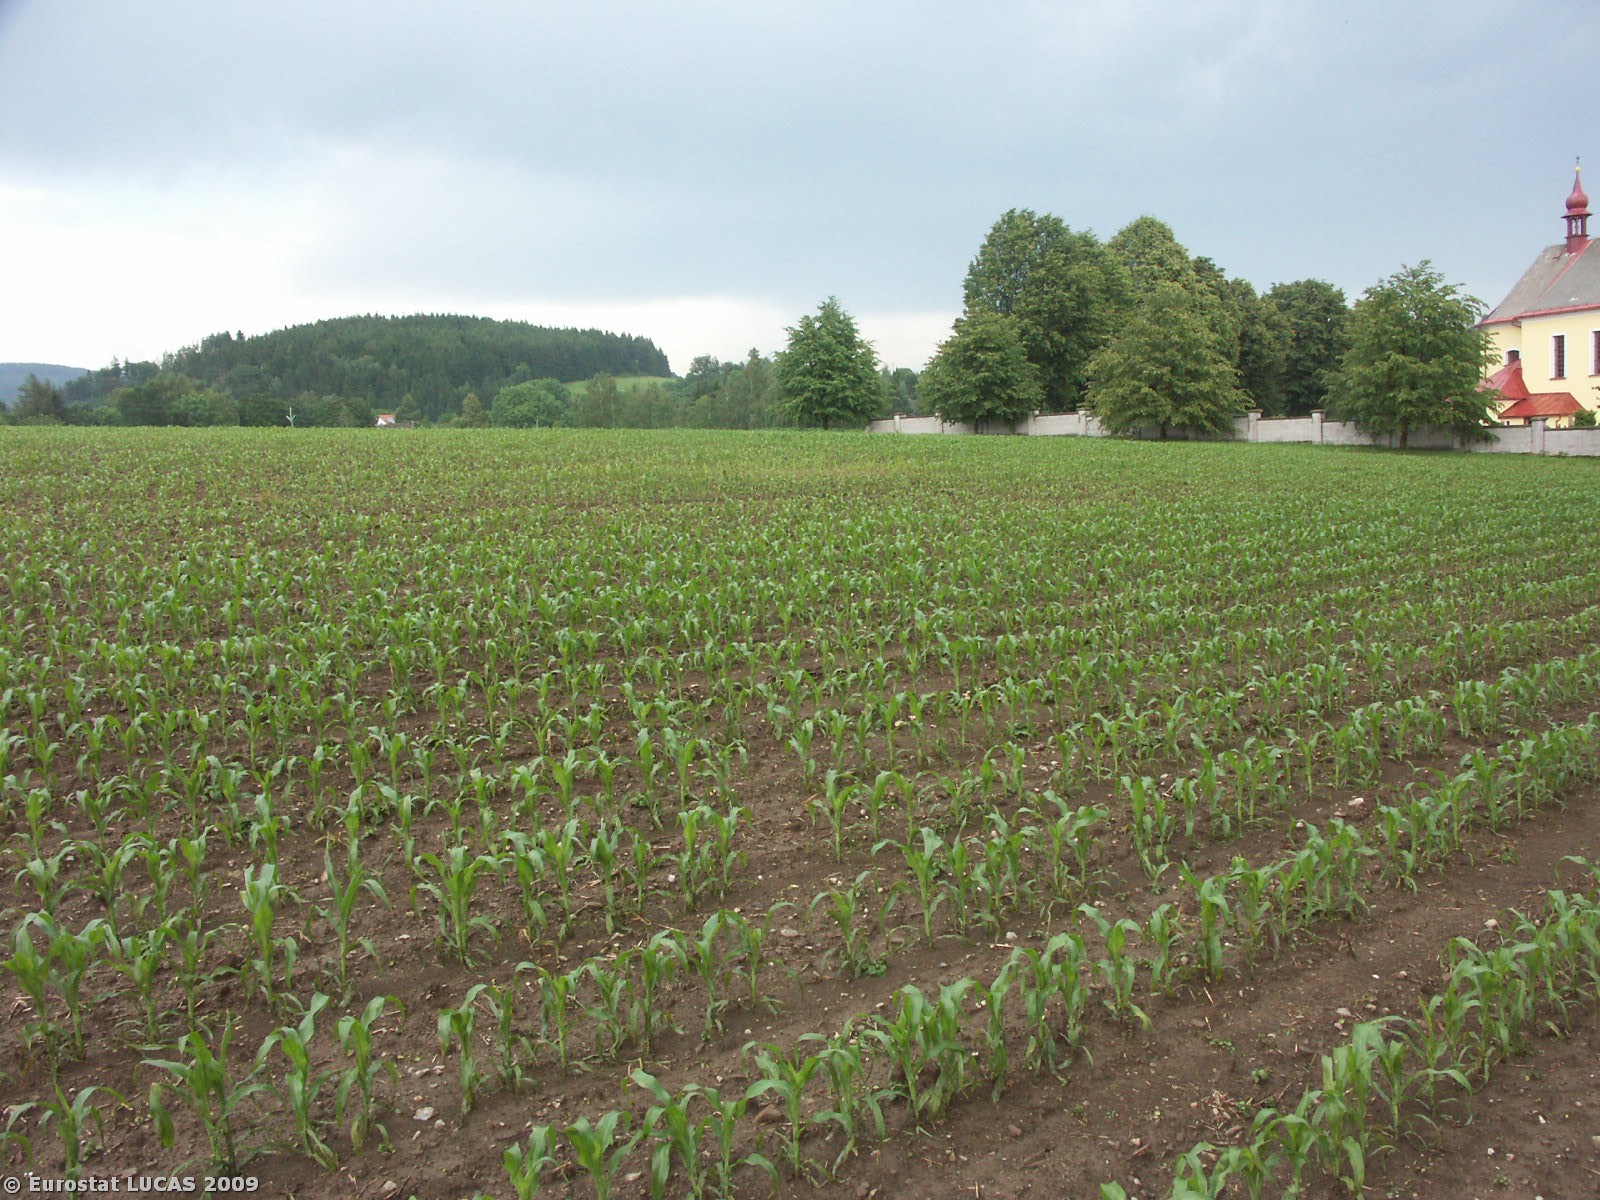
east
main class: Cropland
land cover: Maize
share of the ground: 10 - 25 %
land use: Agriculture (excluding fallow land and kitchen gardens)
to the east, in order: Maize; Broadleaved woodland; Potatoes; Common wheat; Grass margins; Tracks; Artificial constructions in urban areas
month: July
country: CZ
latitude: 49.9894
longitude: 16.6614
